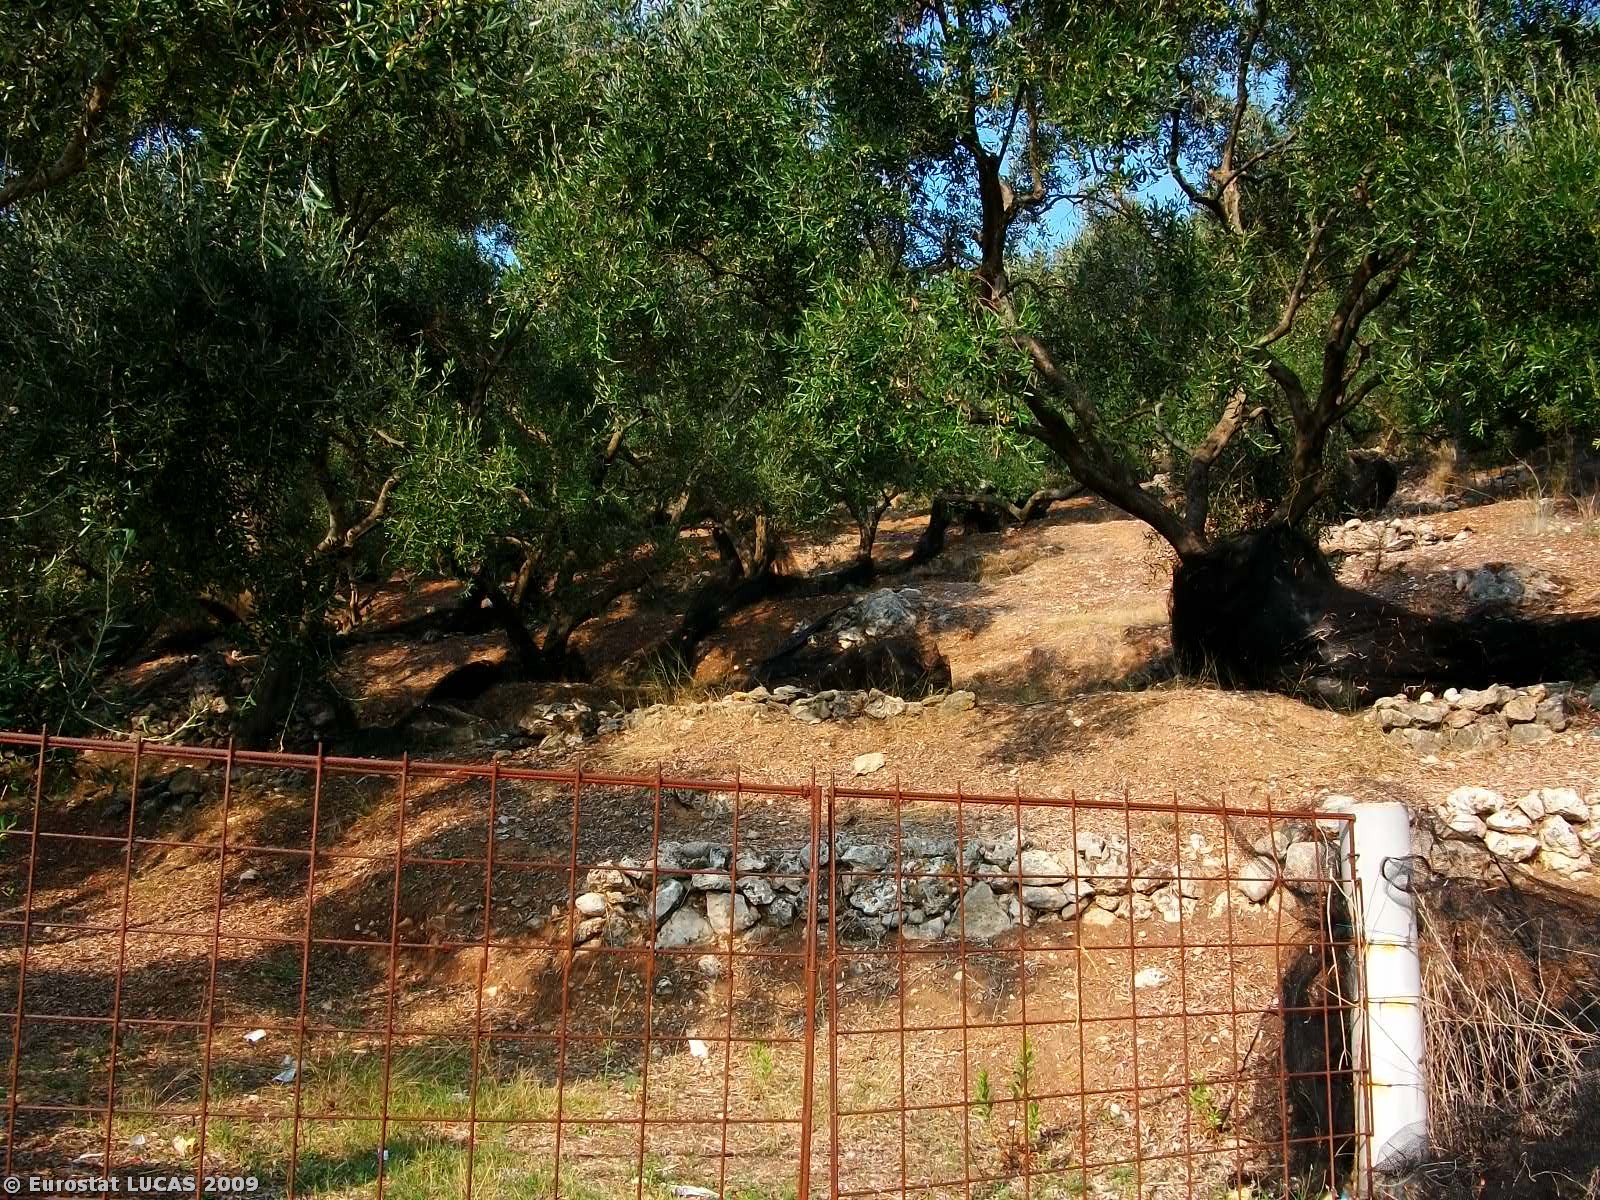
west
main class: Shrubland
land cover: Shrubland without tree cover
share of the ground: > 75 %
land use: Agriculture (excluding fallow land and kitchen gardens)
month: October
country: GR
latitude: 39.2867
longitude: 20.4647
